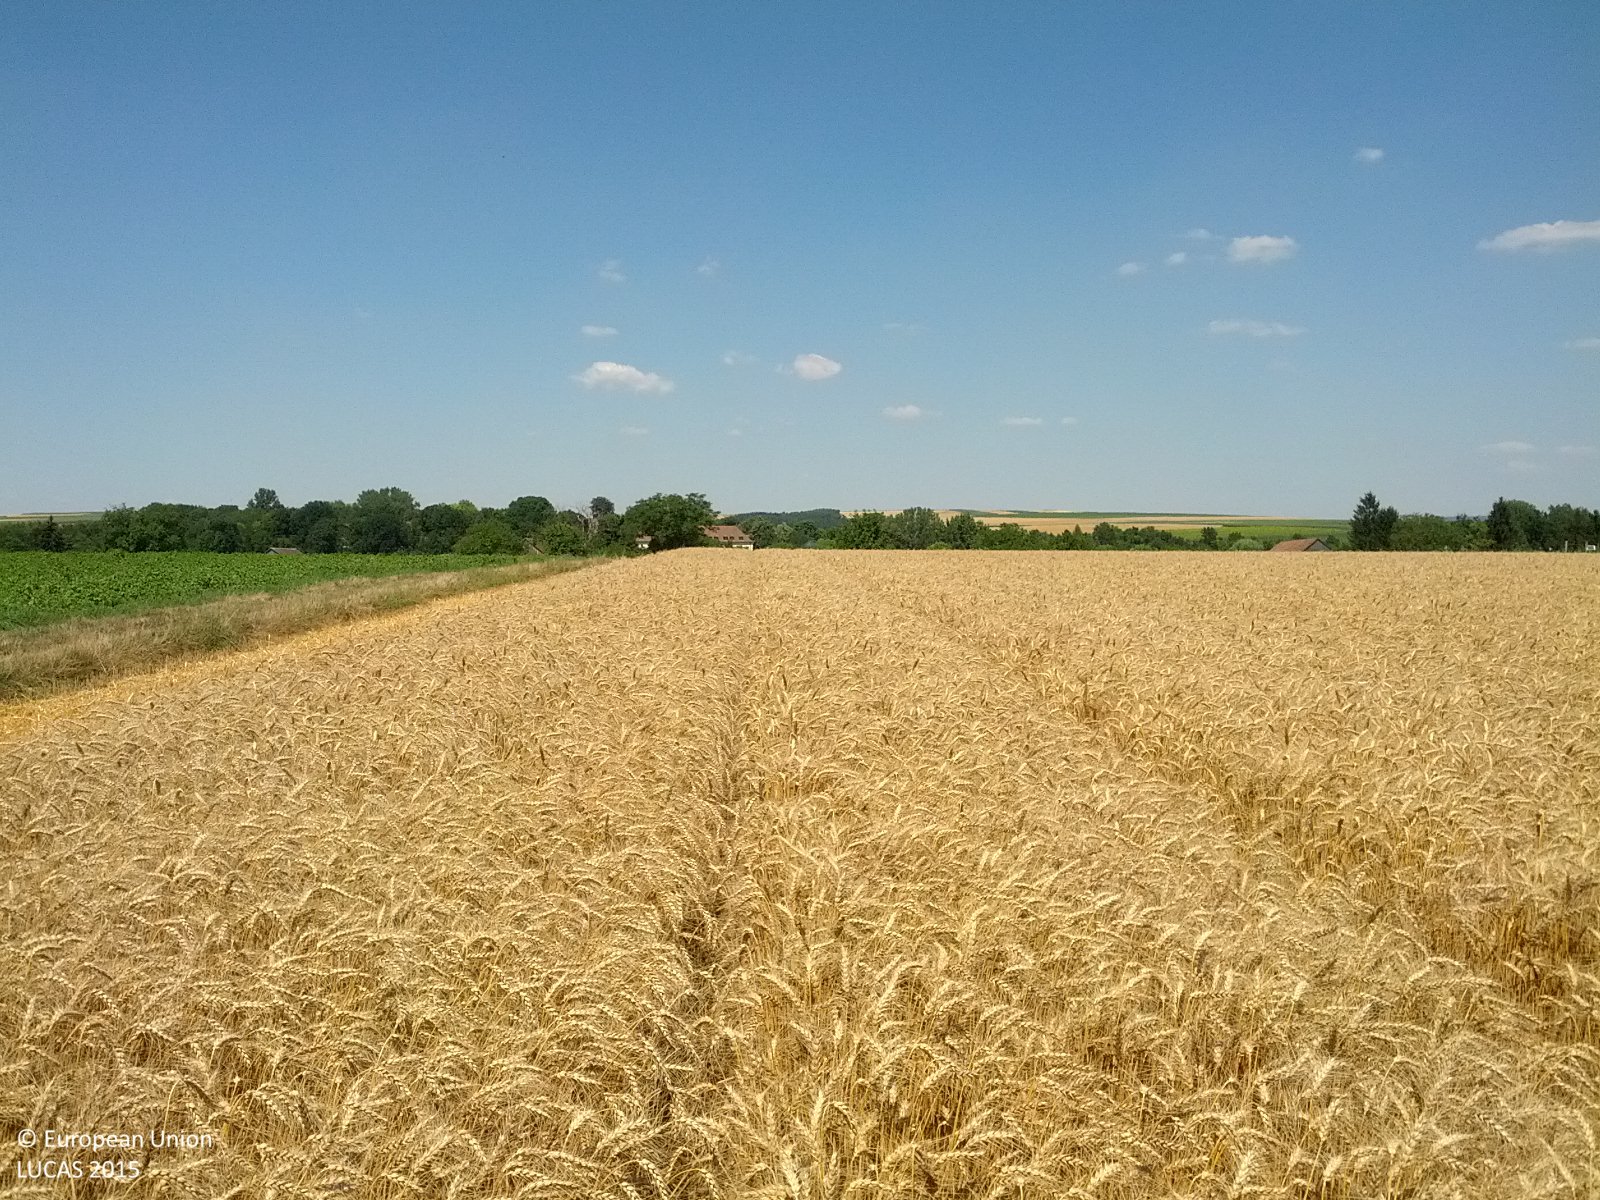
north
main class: Cropland
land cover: Common wheat
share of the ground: > 75 %
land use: Agriculture (excluding fallow land and kitchen gardens)
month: July
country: AT
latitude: 48.4603
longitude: 16.2663
